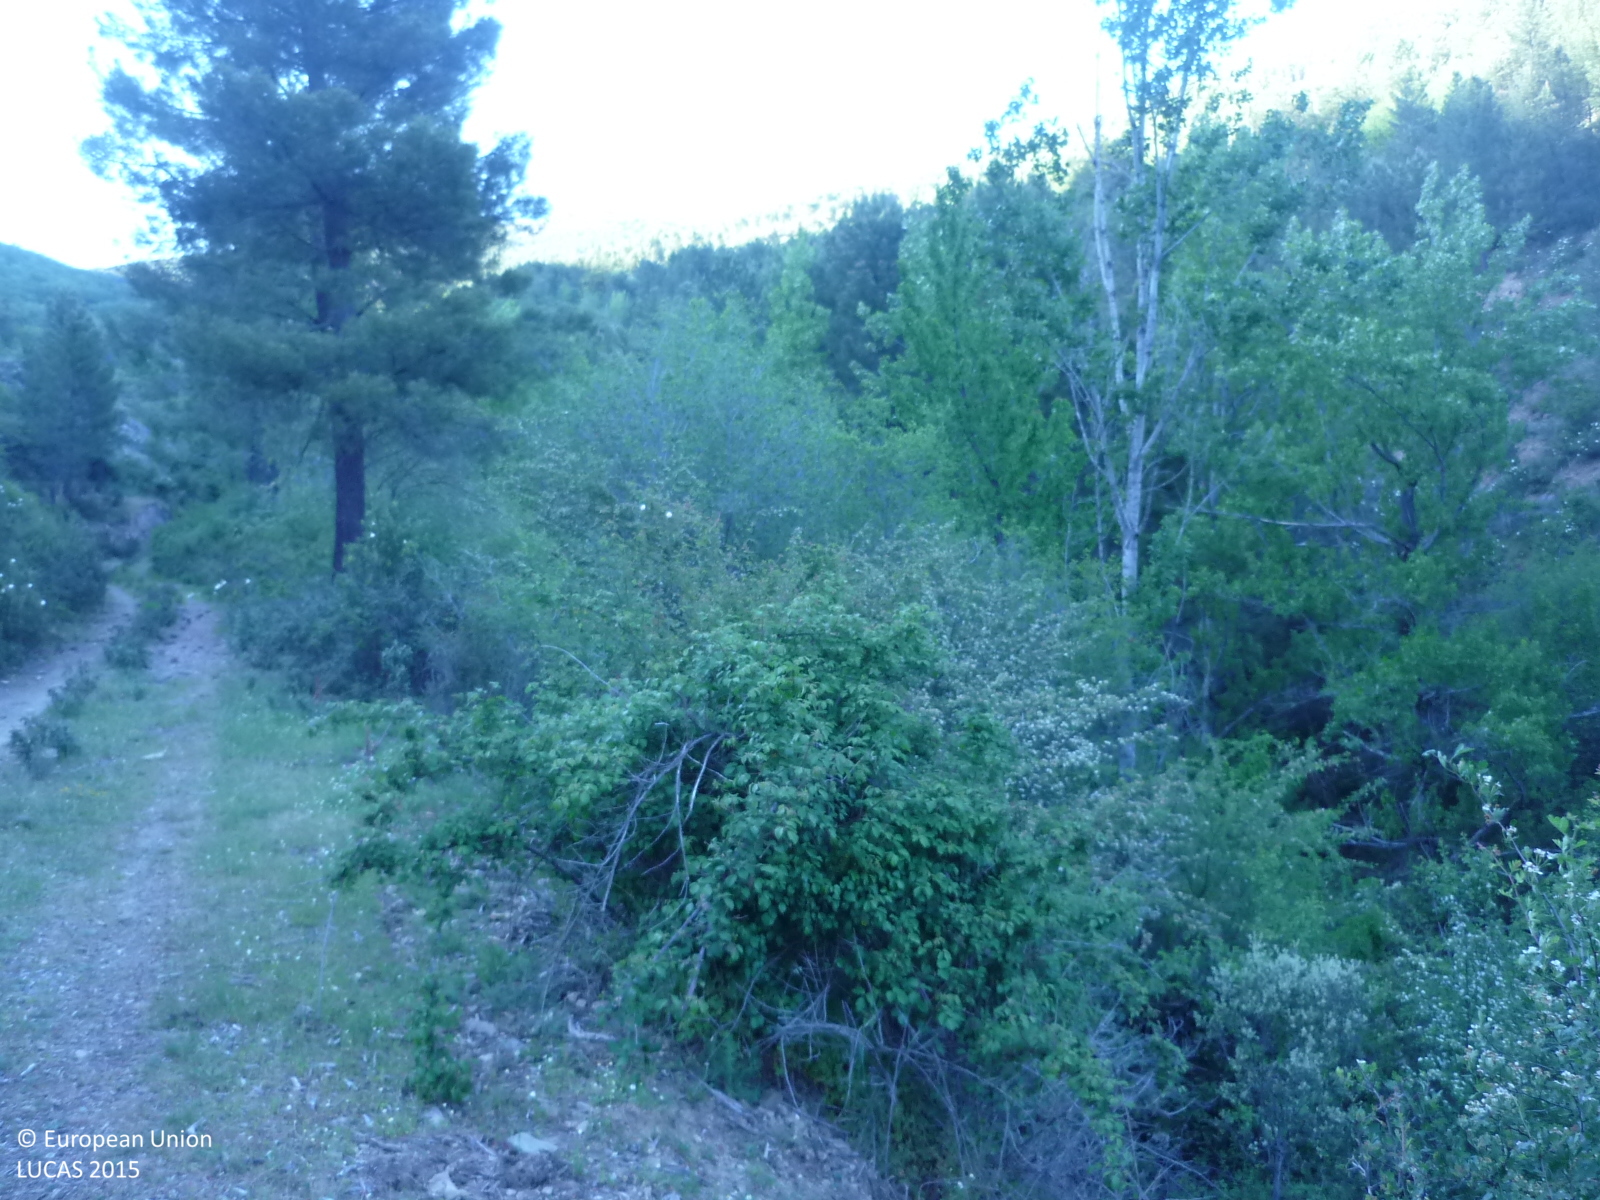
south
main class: Woodland
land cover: Broadleaved woodland
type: thermophilous deciduous forest
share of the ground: > 75 %
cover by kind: broadleaved forest trees 80 %, shrubs 10 %, herbaceous plants 10 %
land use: Semi-natural and natural areas not in use
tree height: < 5 m
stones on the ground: < 10 %
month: May
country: ES
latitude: 41.0311
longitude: -3.3741
